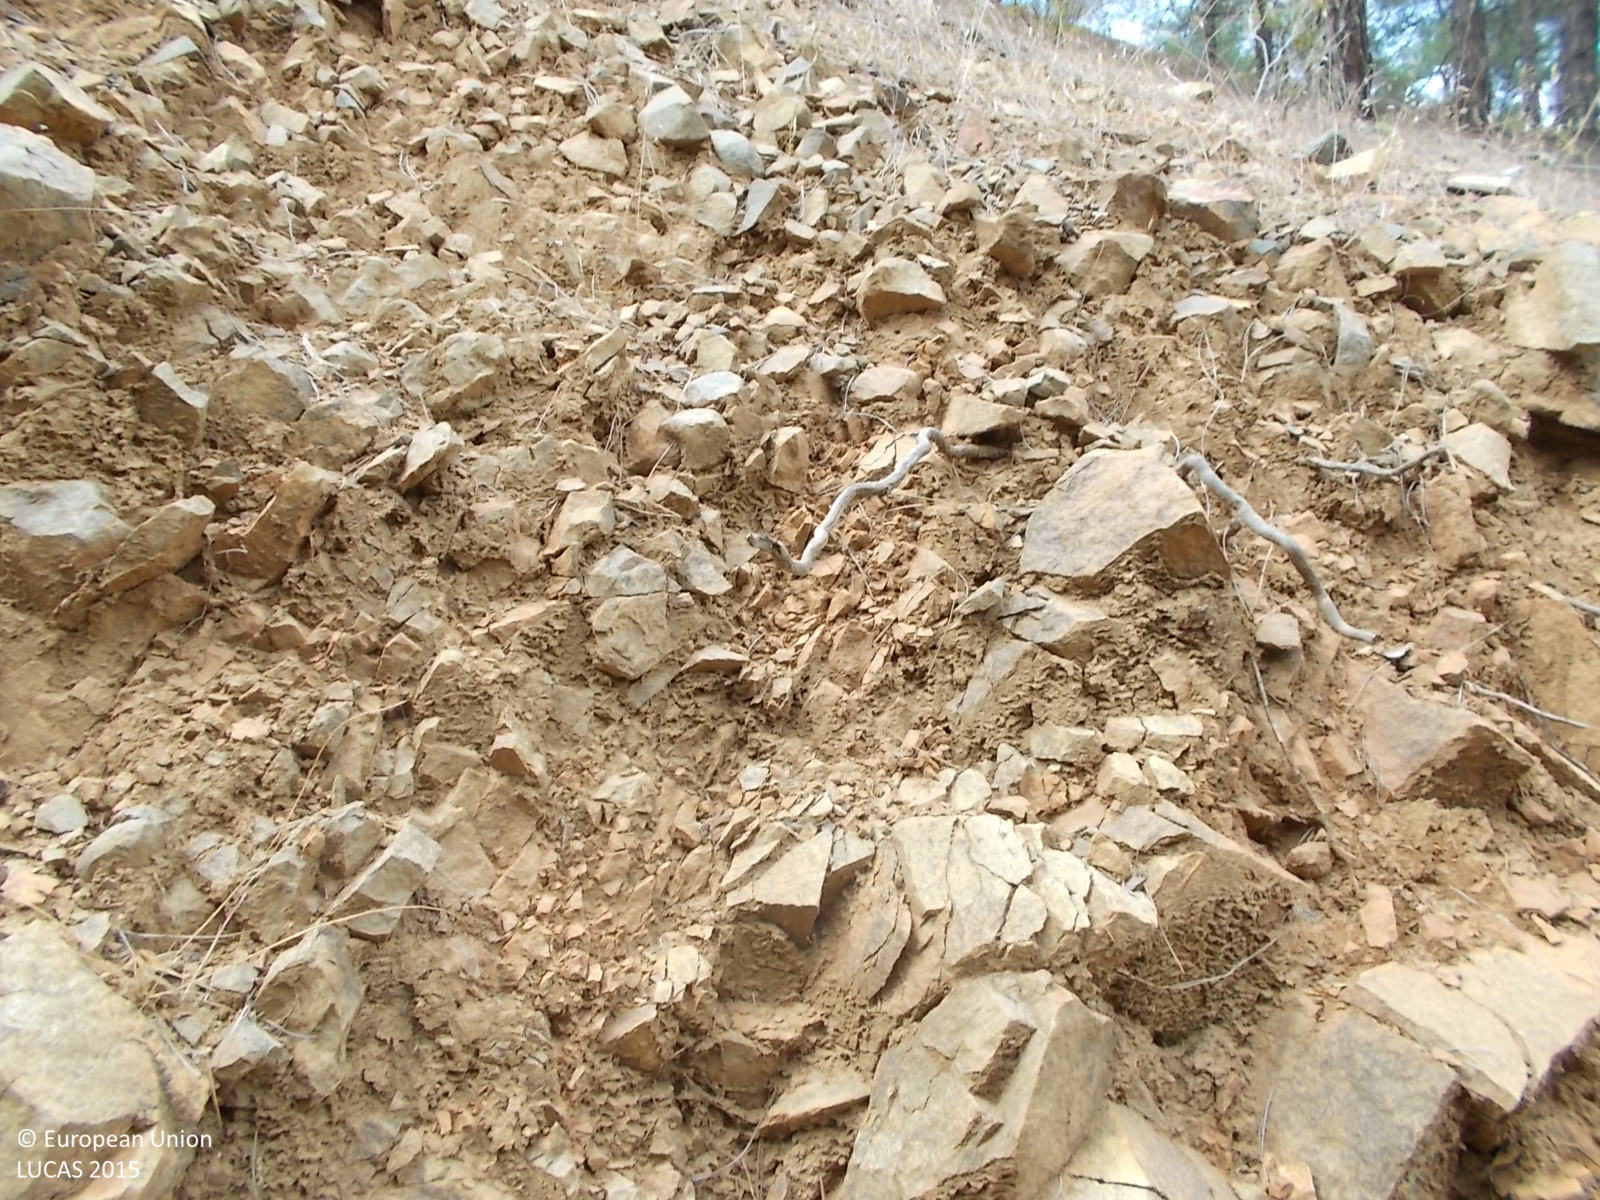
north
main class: Woodland
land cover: Pine dominated coniferous woodland
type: coniferous forest of the mediterranean region
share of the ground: > 75 %
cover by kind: coniferous forest trees 75 %, unconsolidated bare surface 25 %
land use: Forestry
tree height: > 5 m
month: June
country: CY
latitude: 35.0917
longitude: 32.6385
